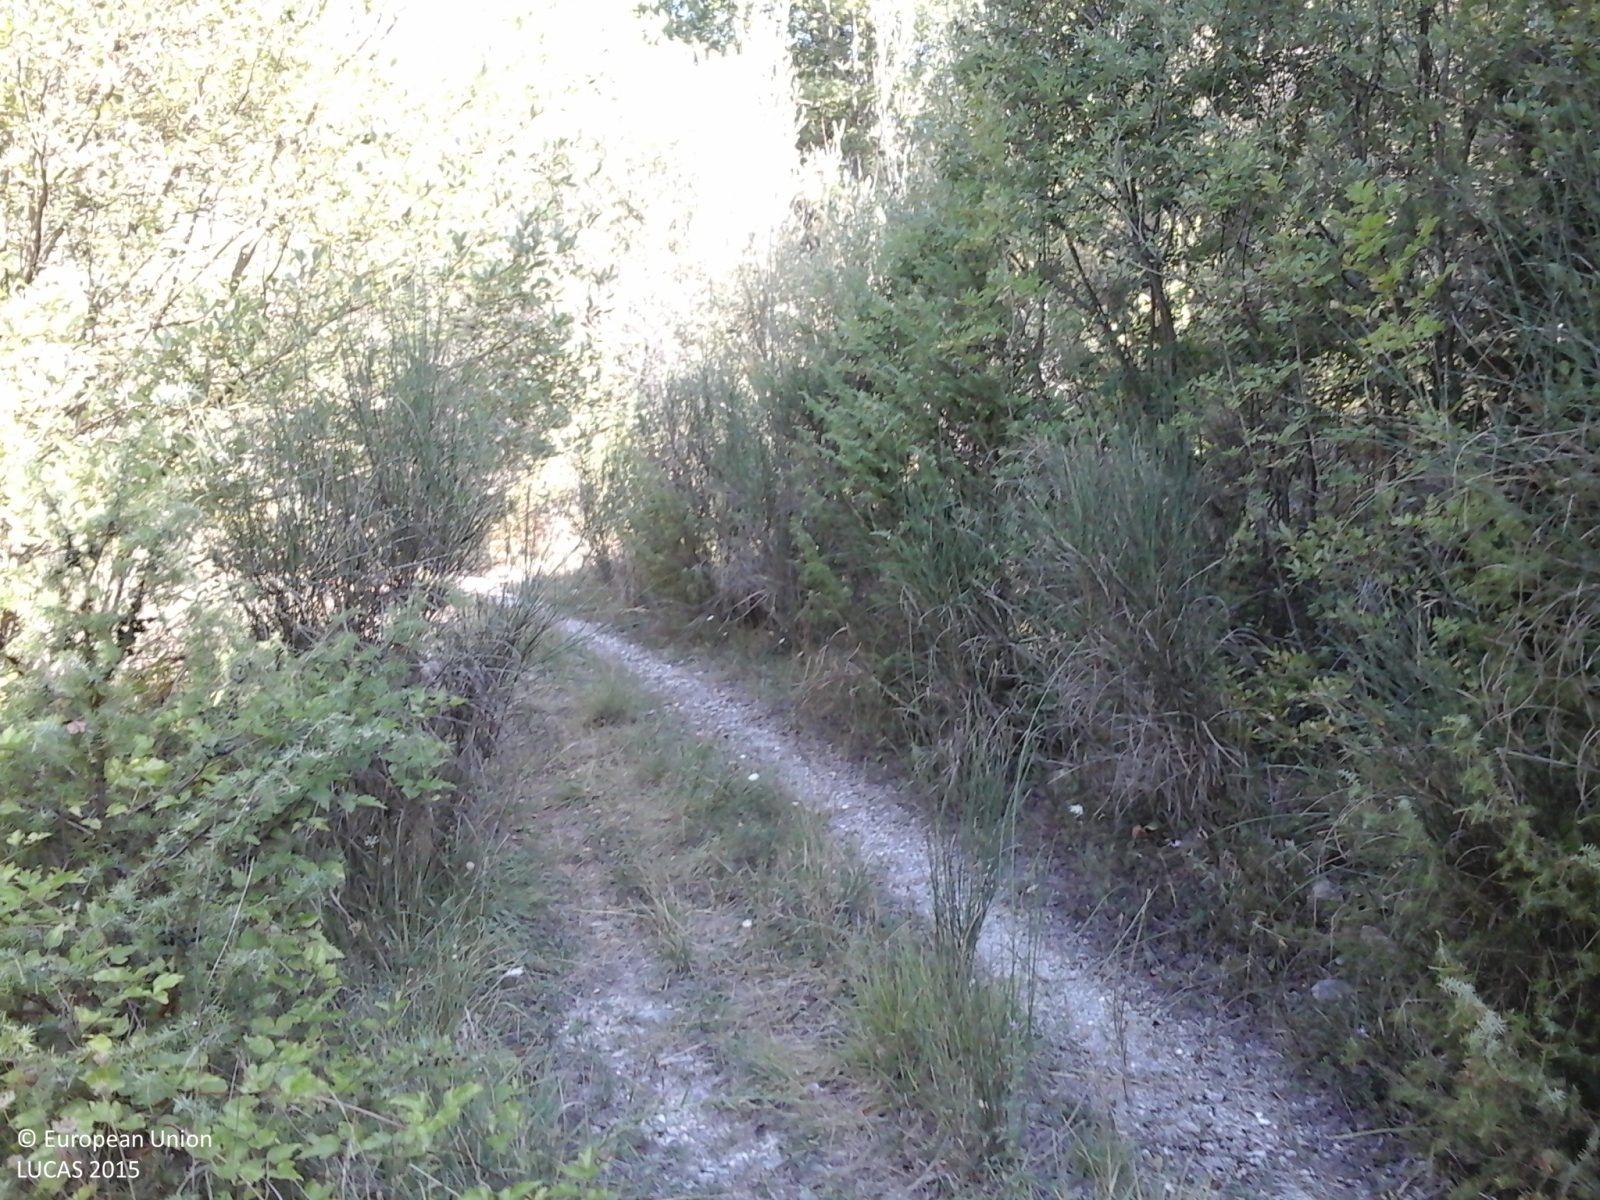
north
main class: Woodland
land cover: Broadleaved woodland
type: thermophilous deciduous forest
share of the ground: > 75 %
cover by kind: broadleaved forest trees 90 %, shrubs 5 %, herbaceous plants 5 %
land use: Semi-natural and natural areas not in use
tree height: > 5 m
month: September
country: IT
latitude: 41.6795
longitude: 14.2256
